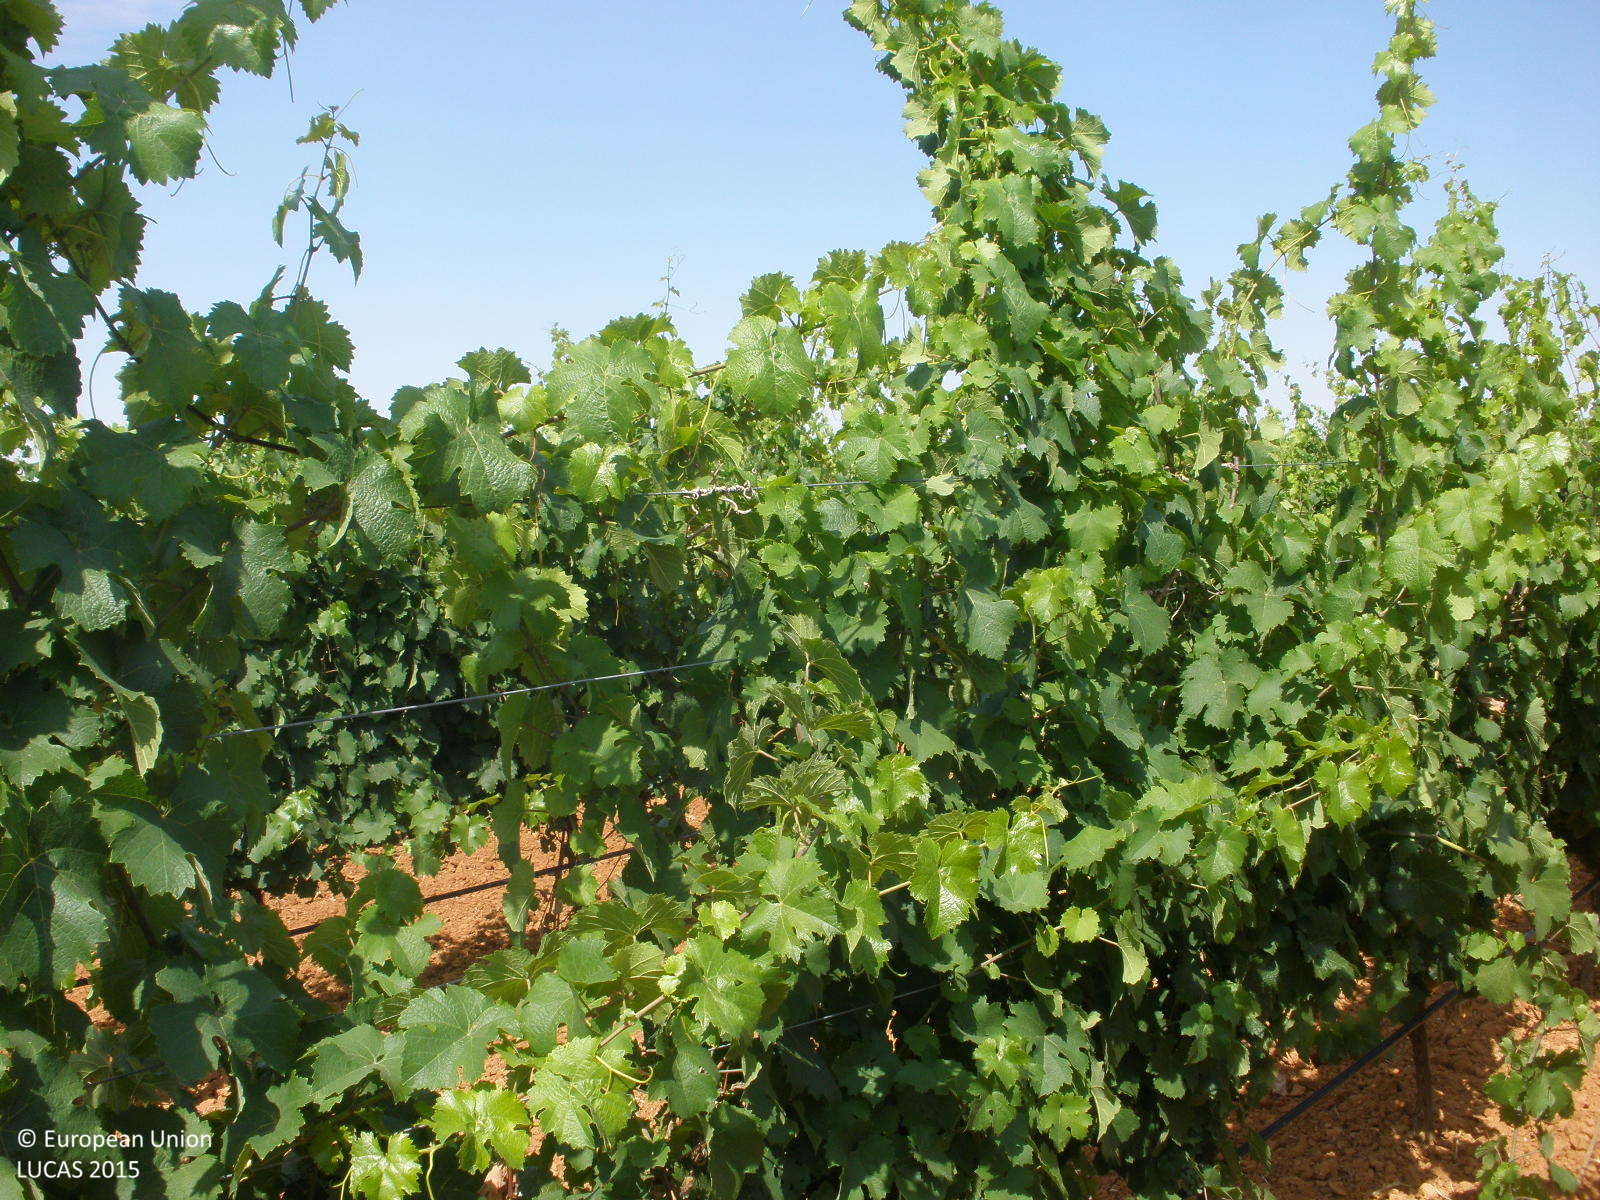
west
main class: Cropland
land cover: Vineyards
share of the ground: 50 - 75 %
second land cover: Other bare soil
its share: > 75 %
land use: Agriculture (excluding fallow land and kitchen gardens)
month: July
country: ES
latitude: 39.8362
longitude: -3.1458
